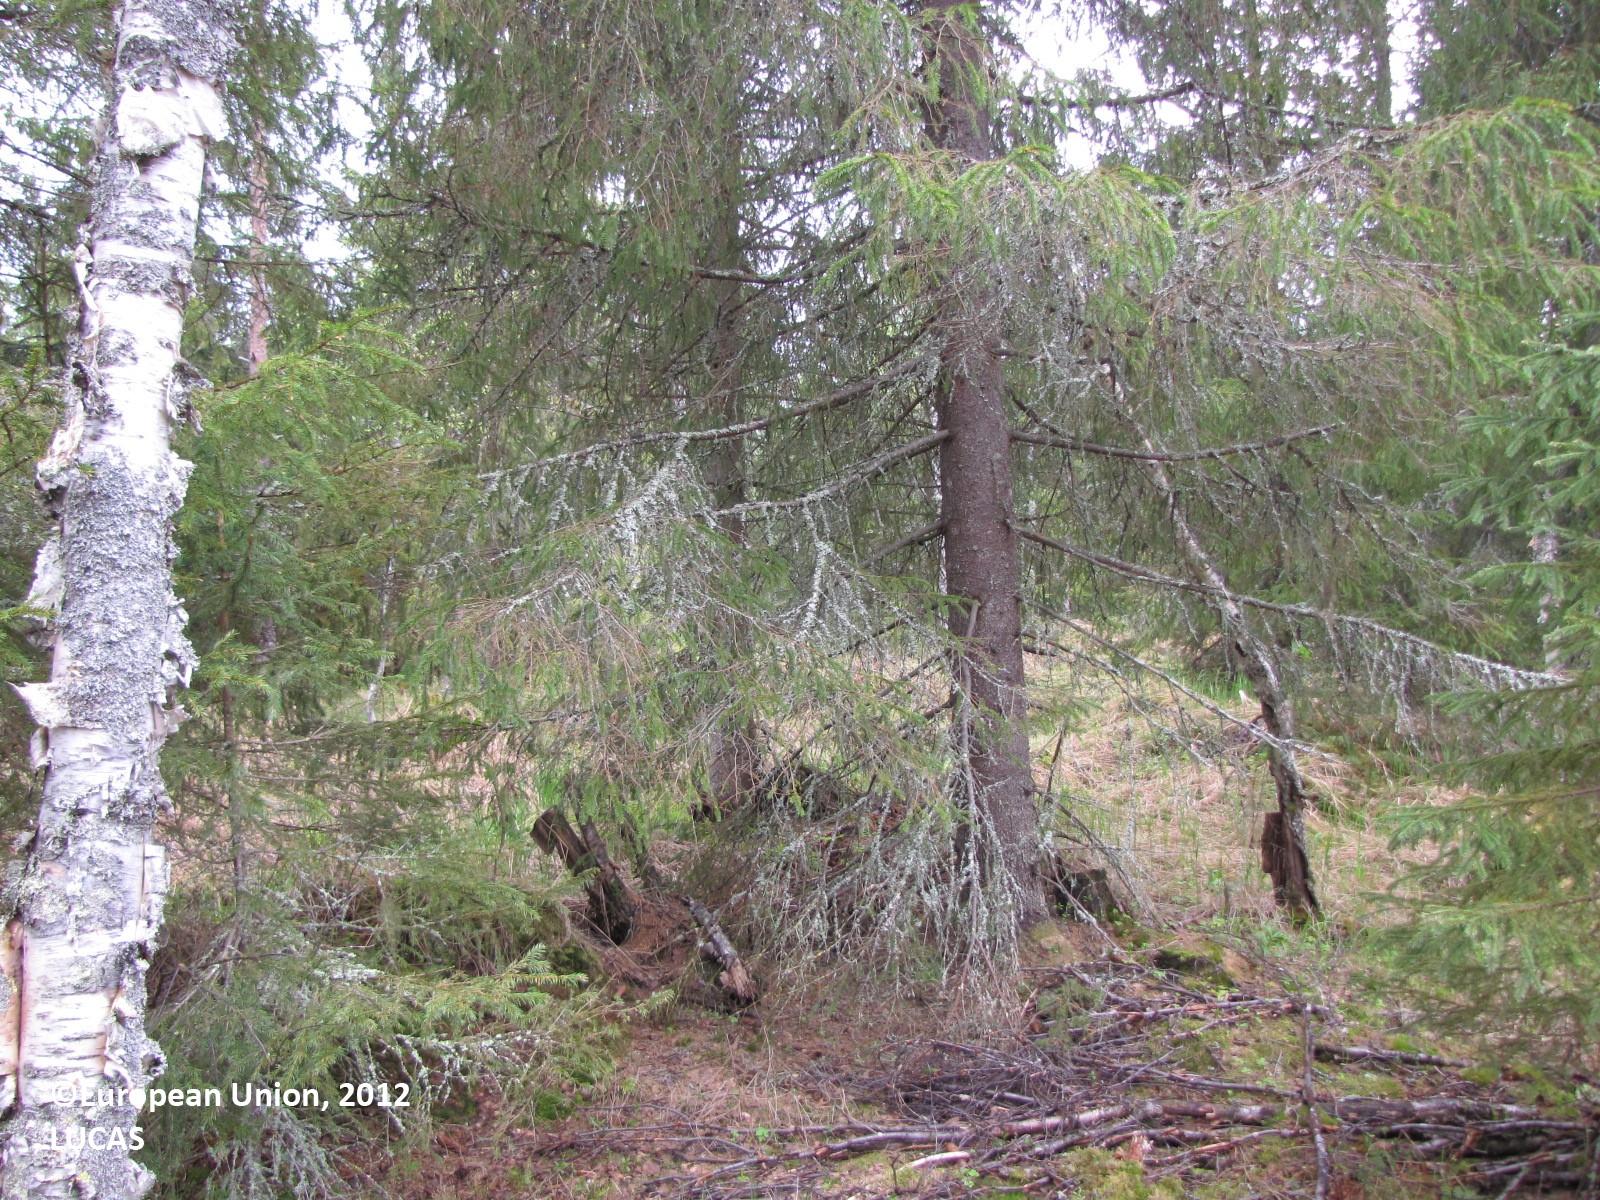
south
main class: Woodland
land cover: Spruce dominated mixed woodland
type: boreal forest
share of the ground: 50 - 75 %
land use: Forestry
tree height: > 5 m
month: June
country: FI
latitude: 65.9640
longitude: 24.2385
